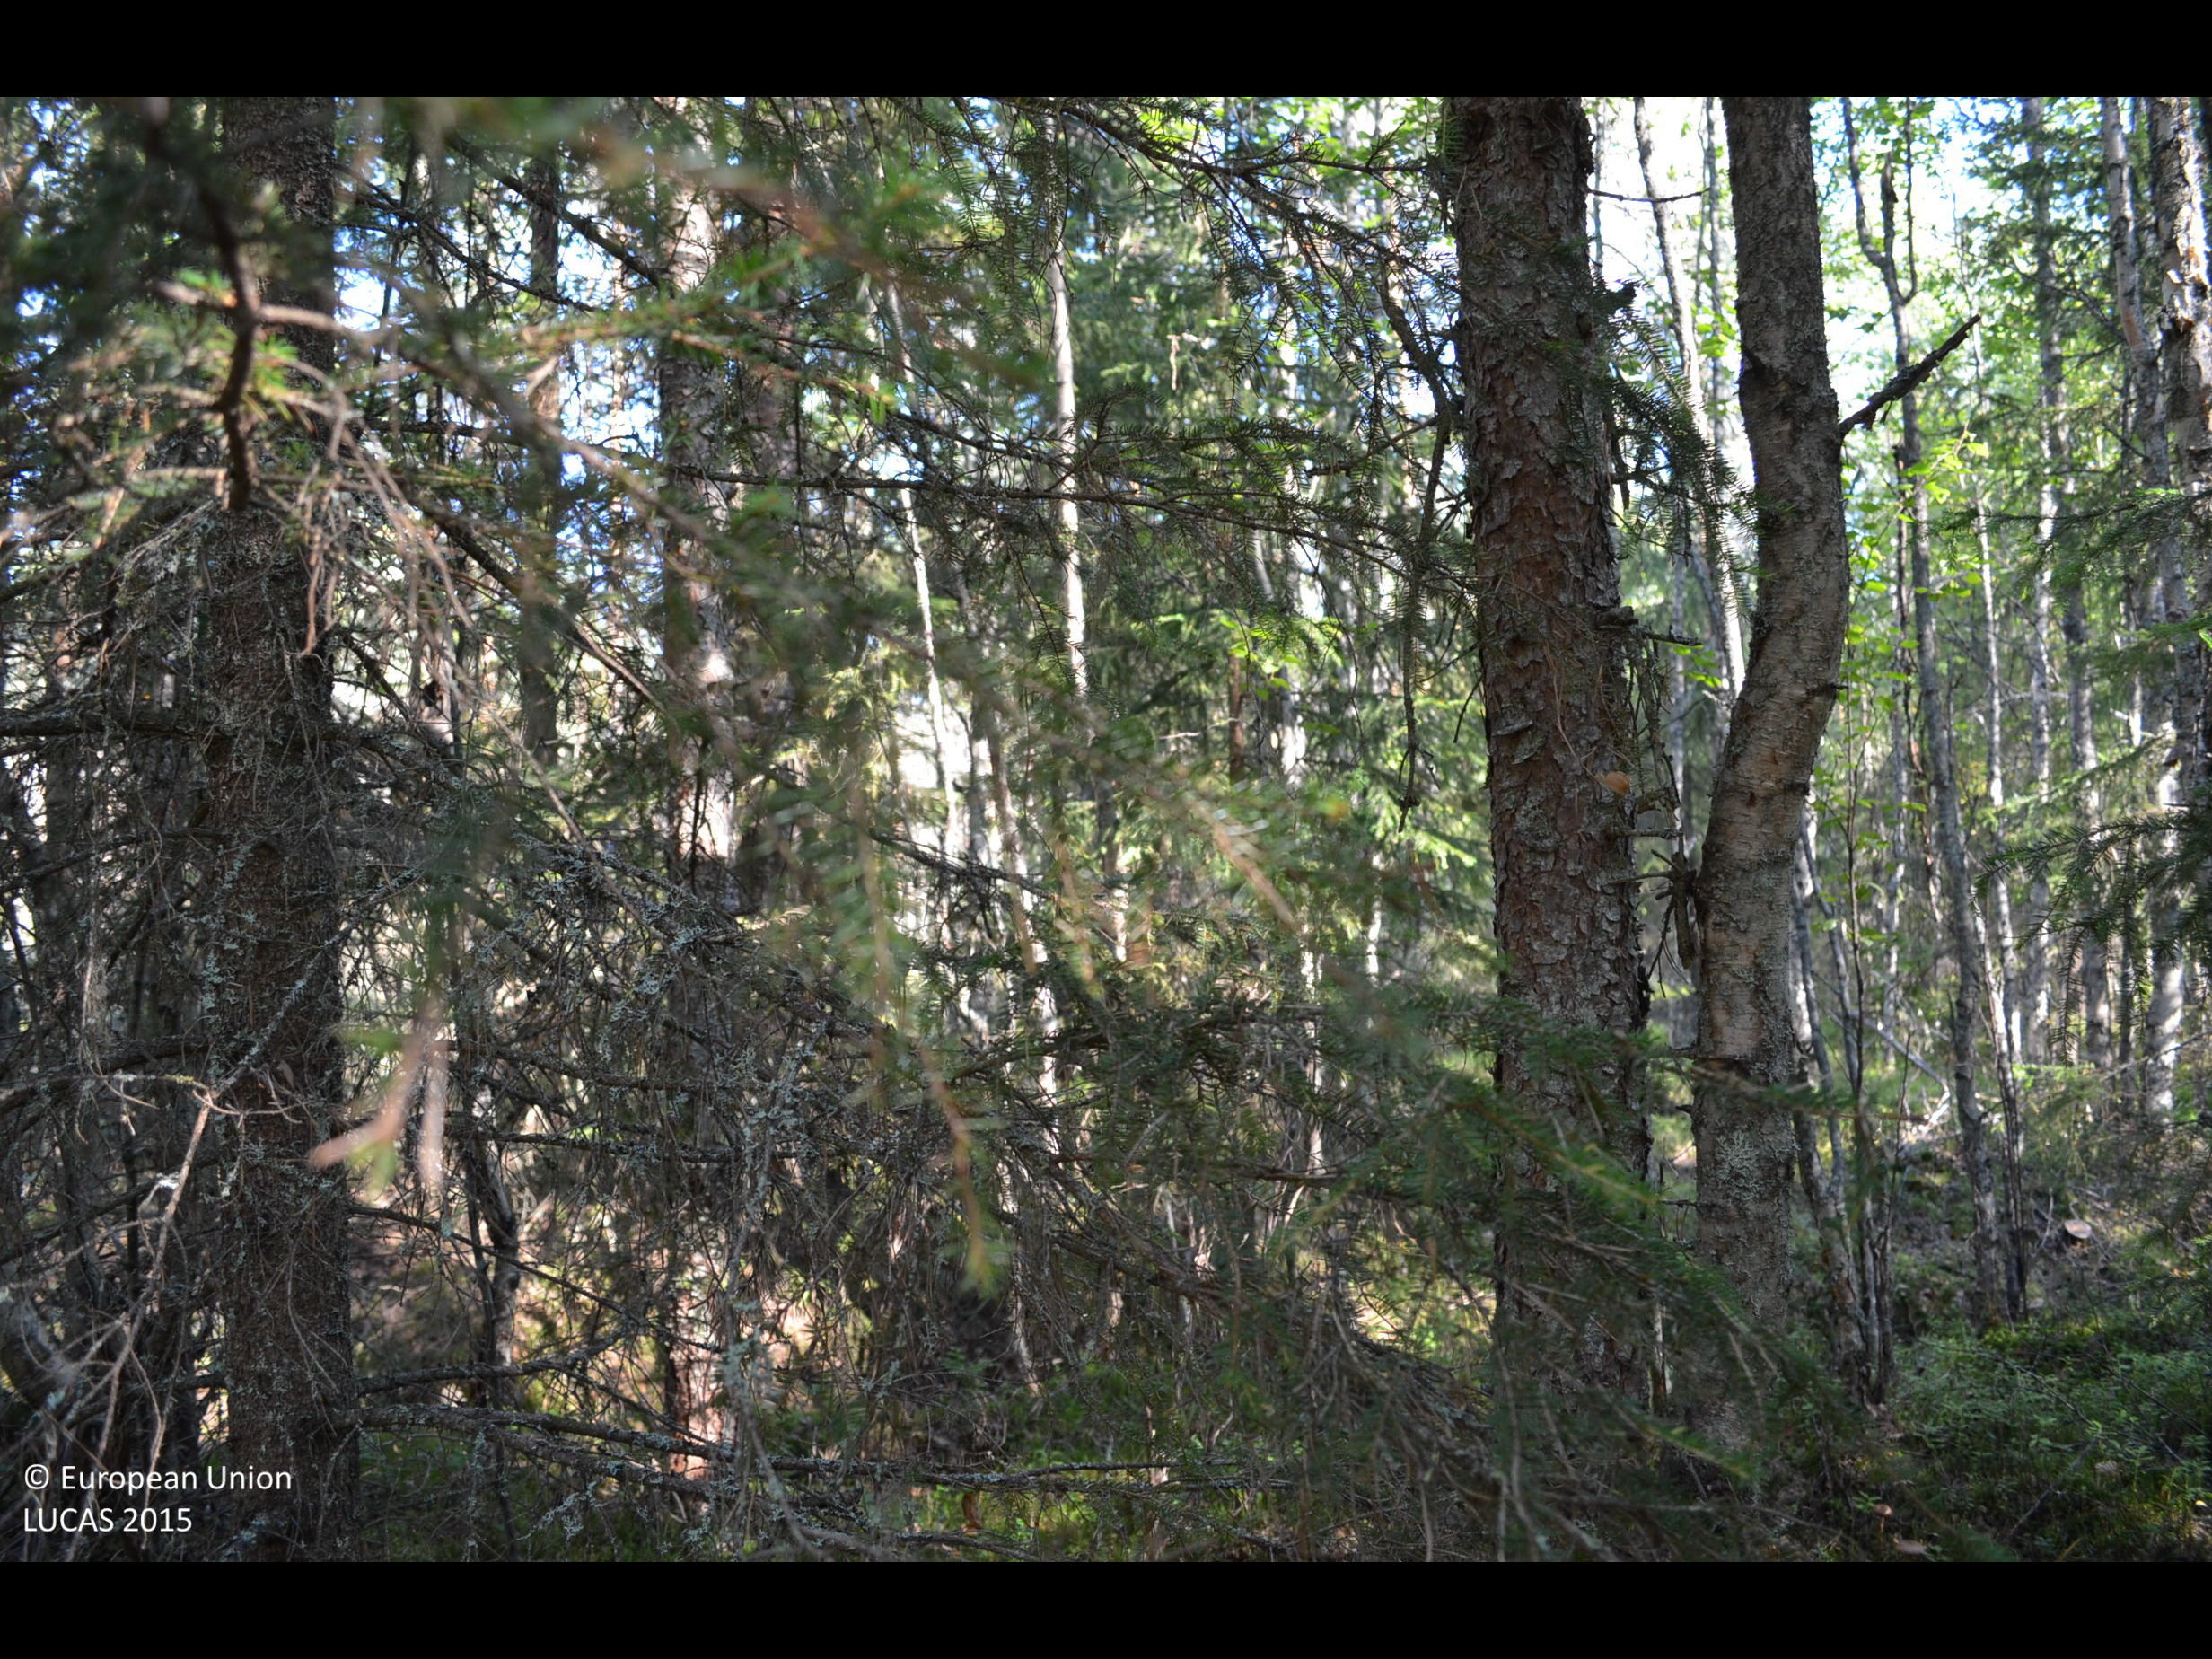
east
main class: Woodland
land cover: Pine dominated mixed woodland
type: boreal forest
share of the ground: > 75 %
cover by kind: coniferous forest trees 60 %, broadleaved forest trees 25 %, shrubs 5 %, lichens and mosses 5 %
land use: Forestry
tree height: > 5 m
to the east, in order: Pine dominated mixed woodland; Ditches and canals; Pine dominated mixed woodland; Pine dominated coniferous woodland; Ditches and canals; Pine dominated mixed woodland; Ditches and canals; Pine dominated mixed woodland; Shrubland without tree cover
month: August
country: FI
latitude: 62.4723
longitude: 24.3418
